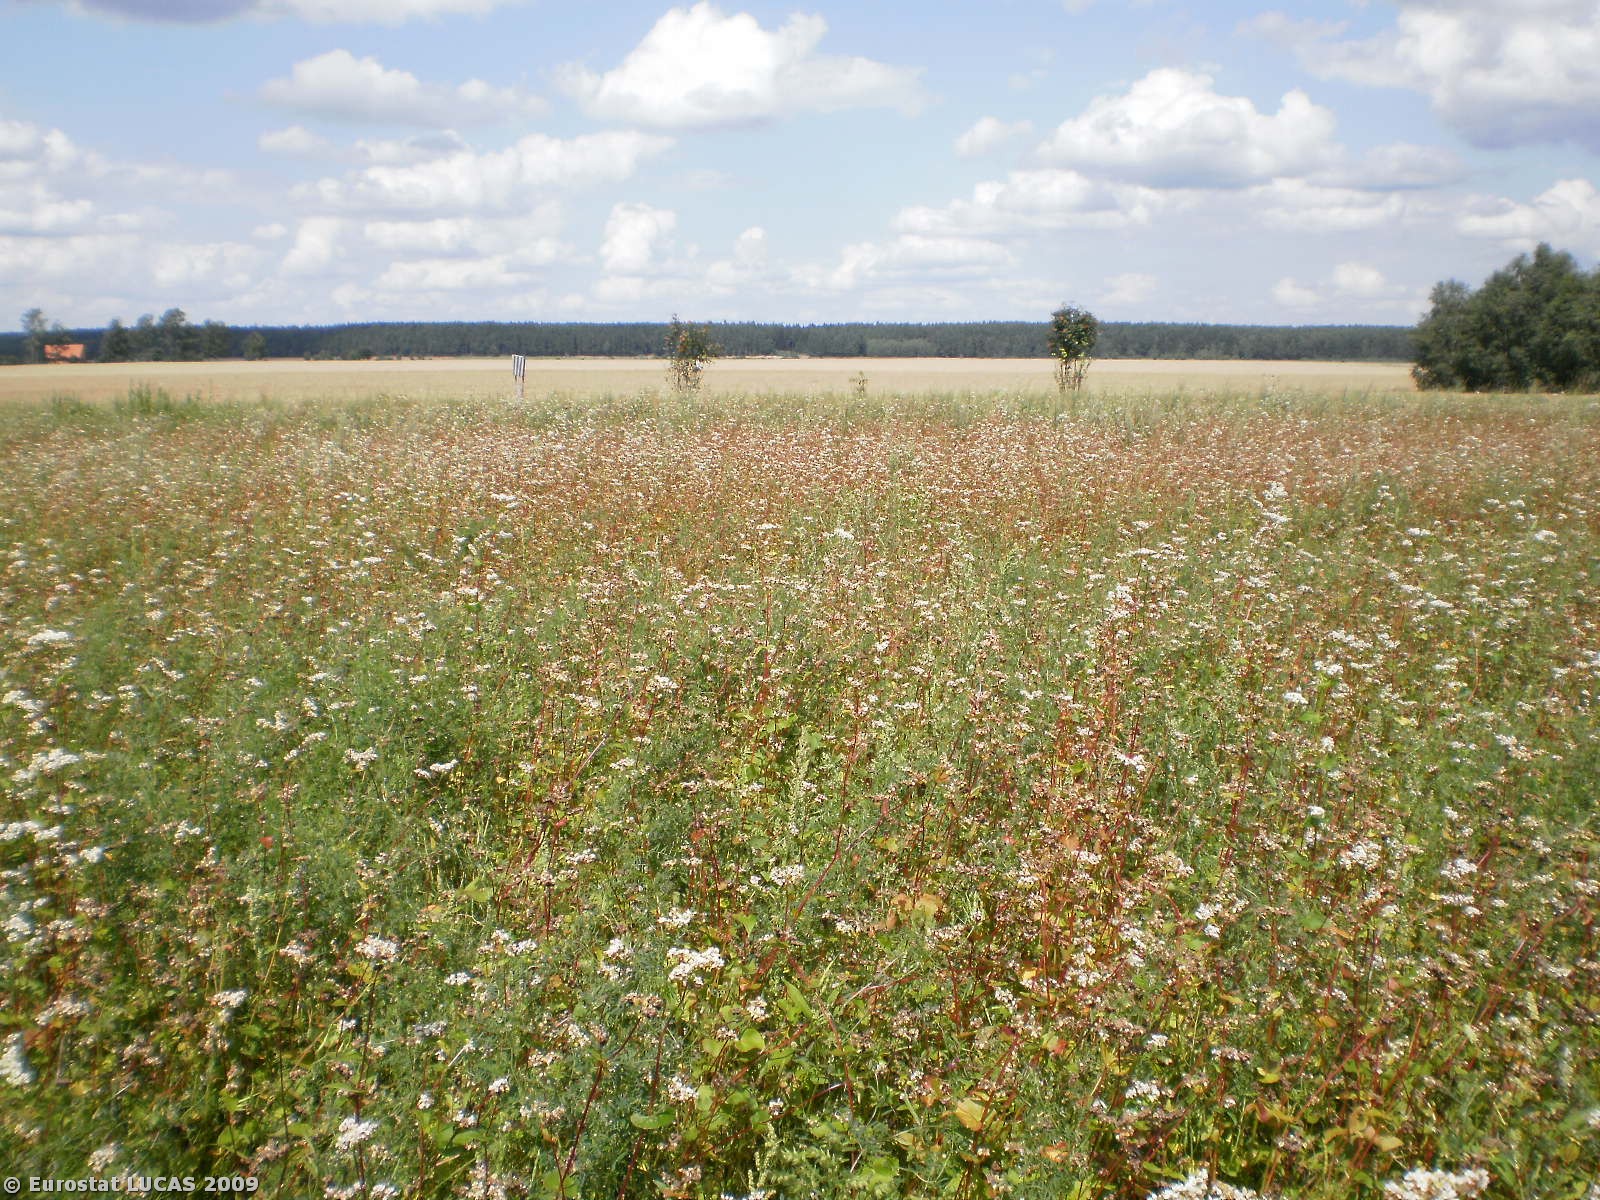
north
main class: Cropland
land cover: Other cereals
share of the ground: > 75 %
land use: Agriculture (excluding fallow land and kitchen gardens)
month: July
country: PL
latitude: 53.4010
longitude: 20.4599
